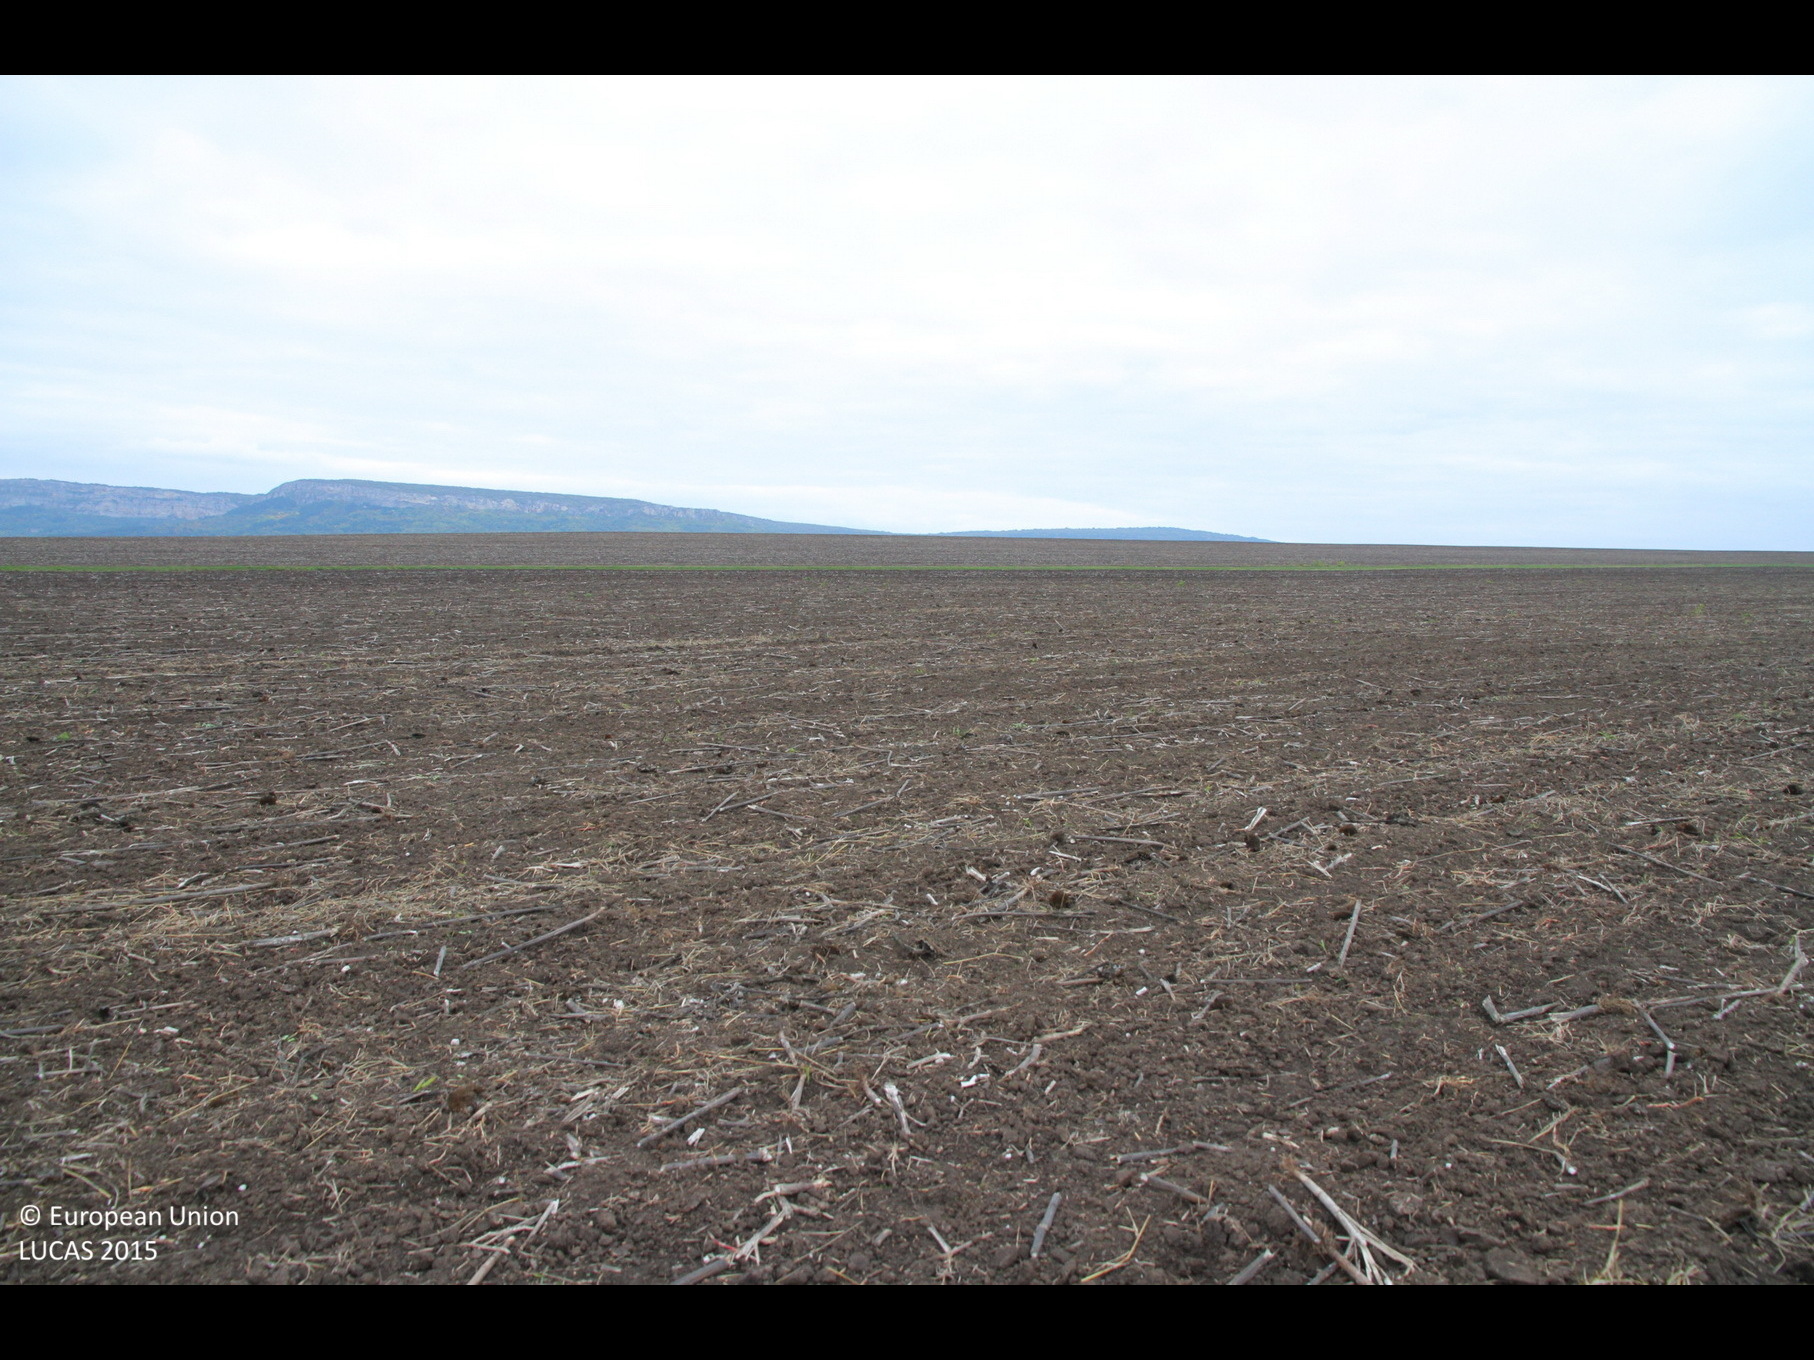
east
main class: Cropland
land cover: Sunflower
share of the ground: < 10 %
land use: Agriculture (excluding fallow land and kitchen gardens)
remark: Harvested field
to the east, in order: Sunflower; Tracks; Sunflower
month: October
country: BG
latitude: 43.2534
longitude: 27.0775
